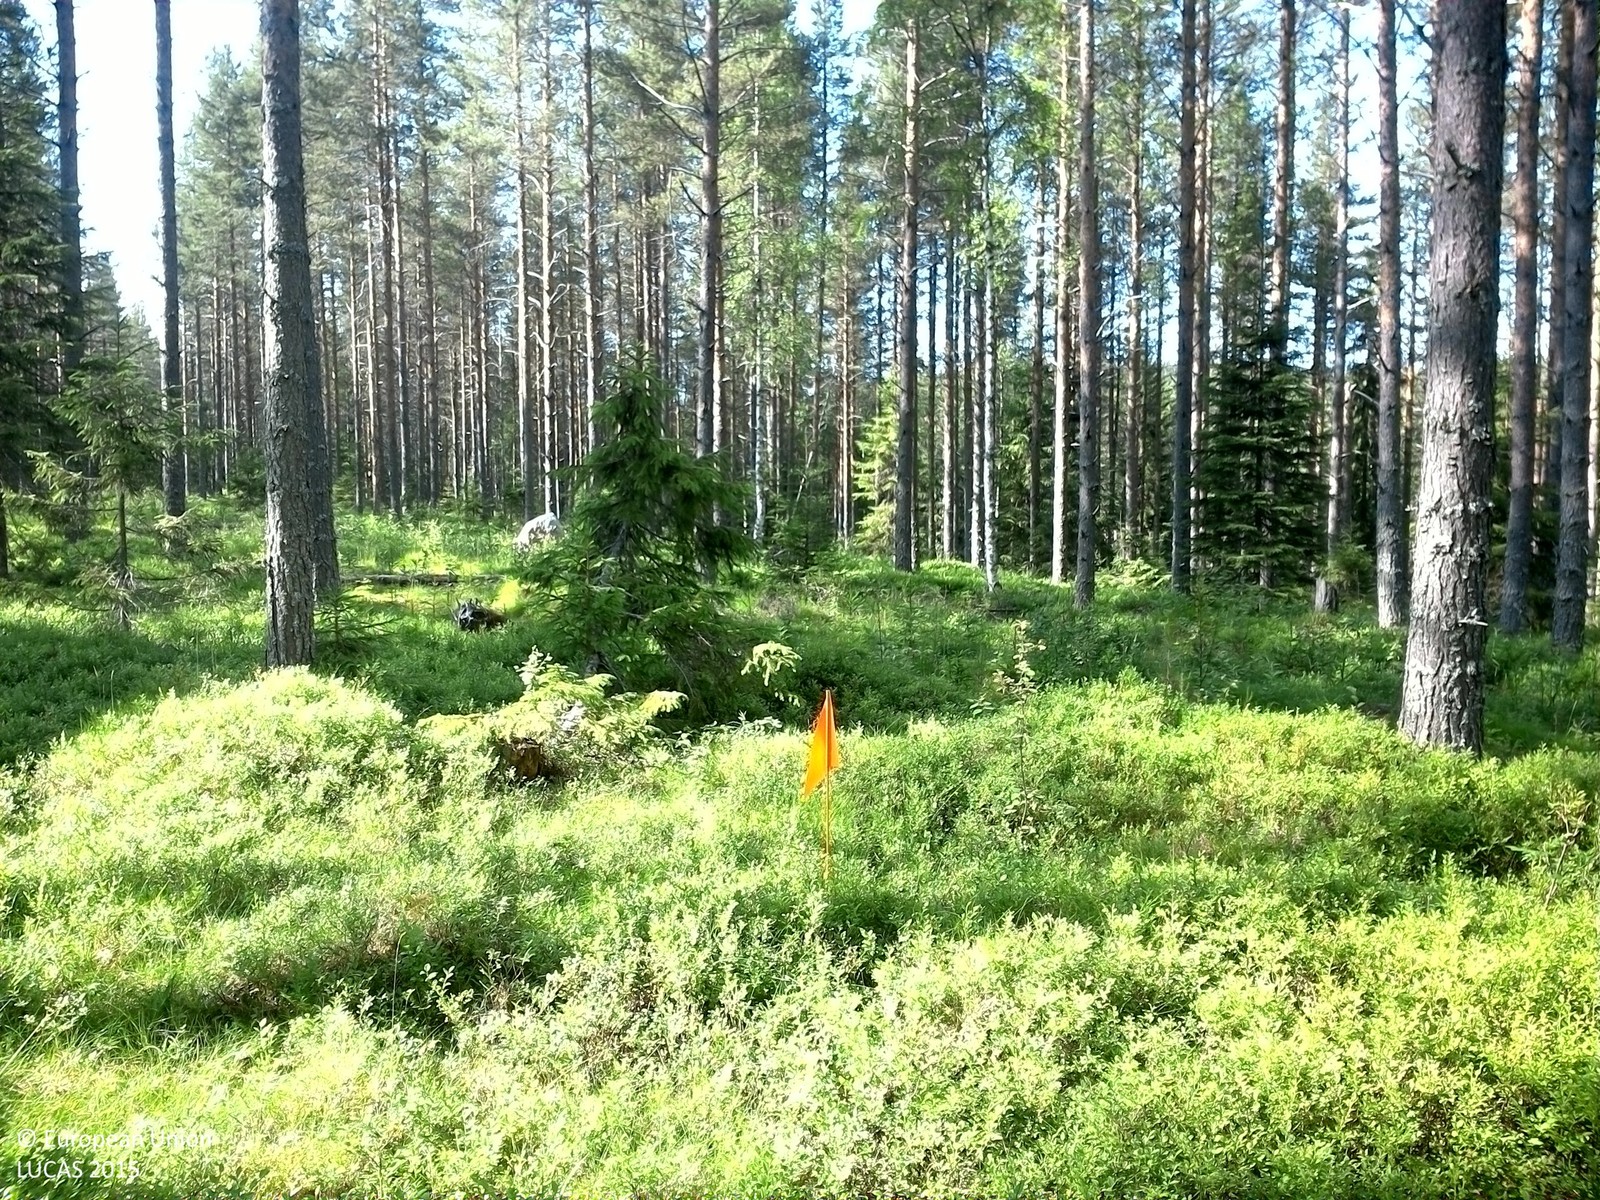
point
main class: Woodland
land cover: Pine dominated coniferous woodland
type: boreal forest
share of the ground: 50 - 75 %
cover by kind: coniferous forest trees 60 %, shrubs 35 %, broadleaved forest trees 5 %
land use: Forestry
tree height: > 5 m
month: July
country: SE
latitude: 63.5306
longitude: 17.5148
